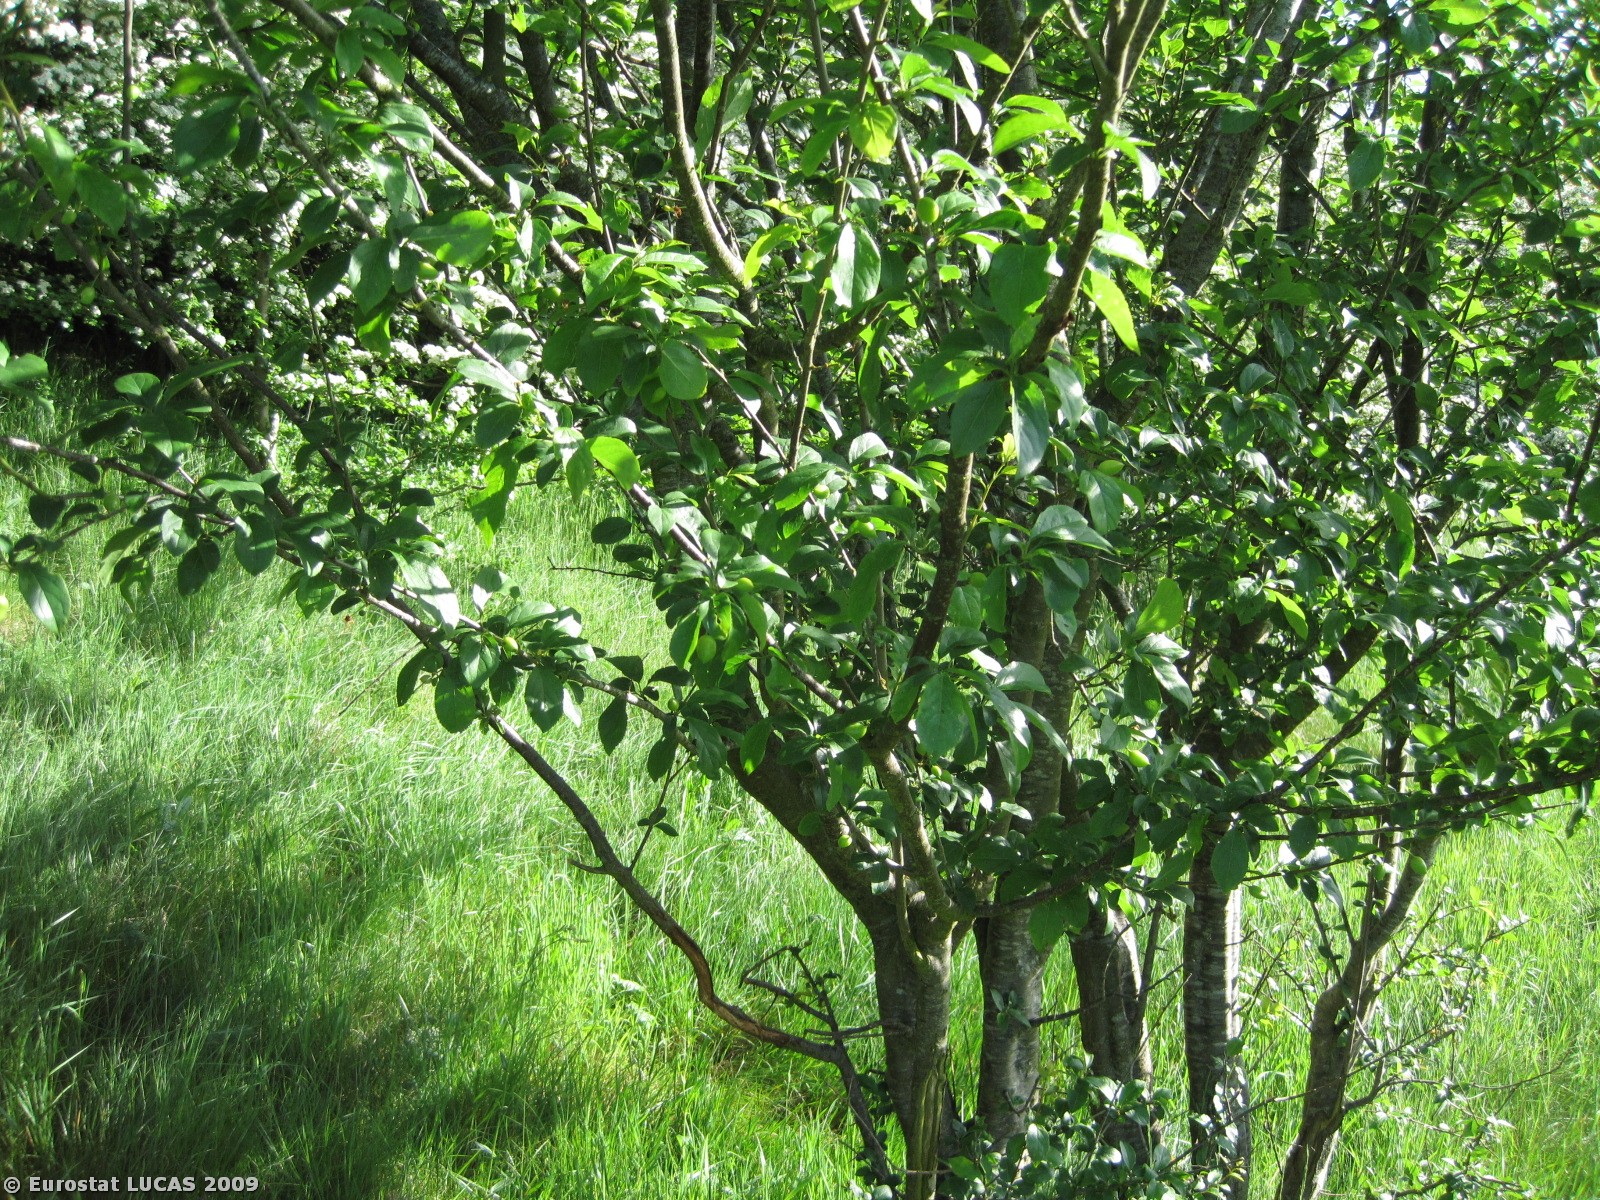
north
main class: Woodland
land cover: Broadleaved woodland
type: mesophytic deciduous forest
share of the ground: > 75 %
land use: Unused
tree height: > 5 m
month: May
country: DK
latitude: 56.5652
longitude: 10.1138
